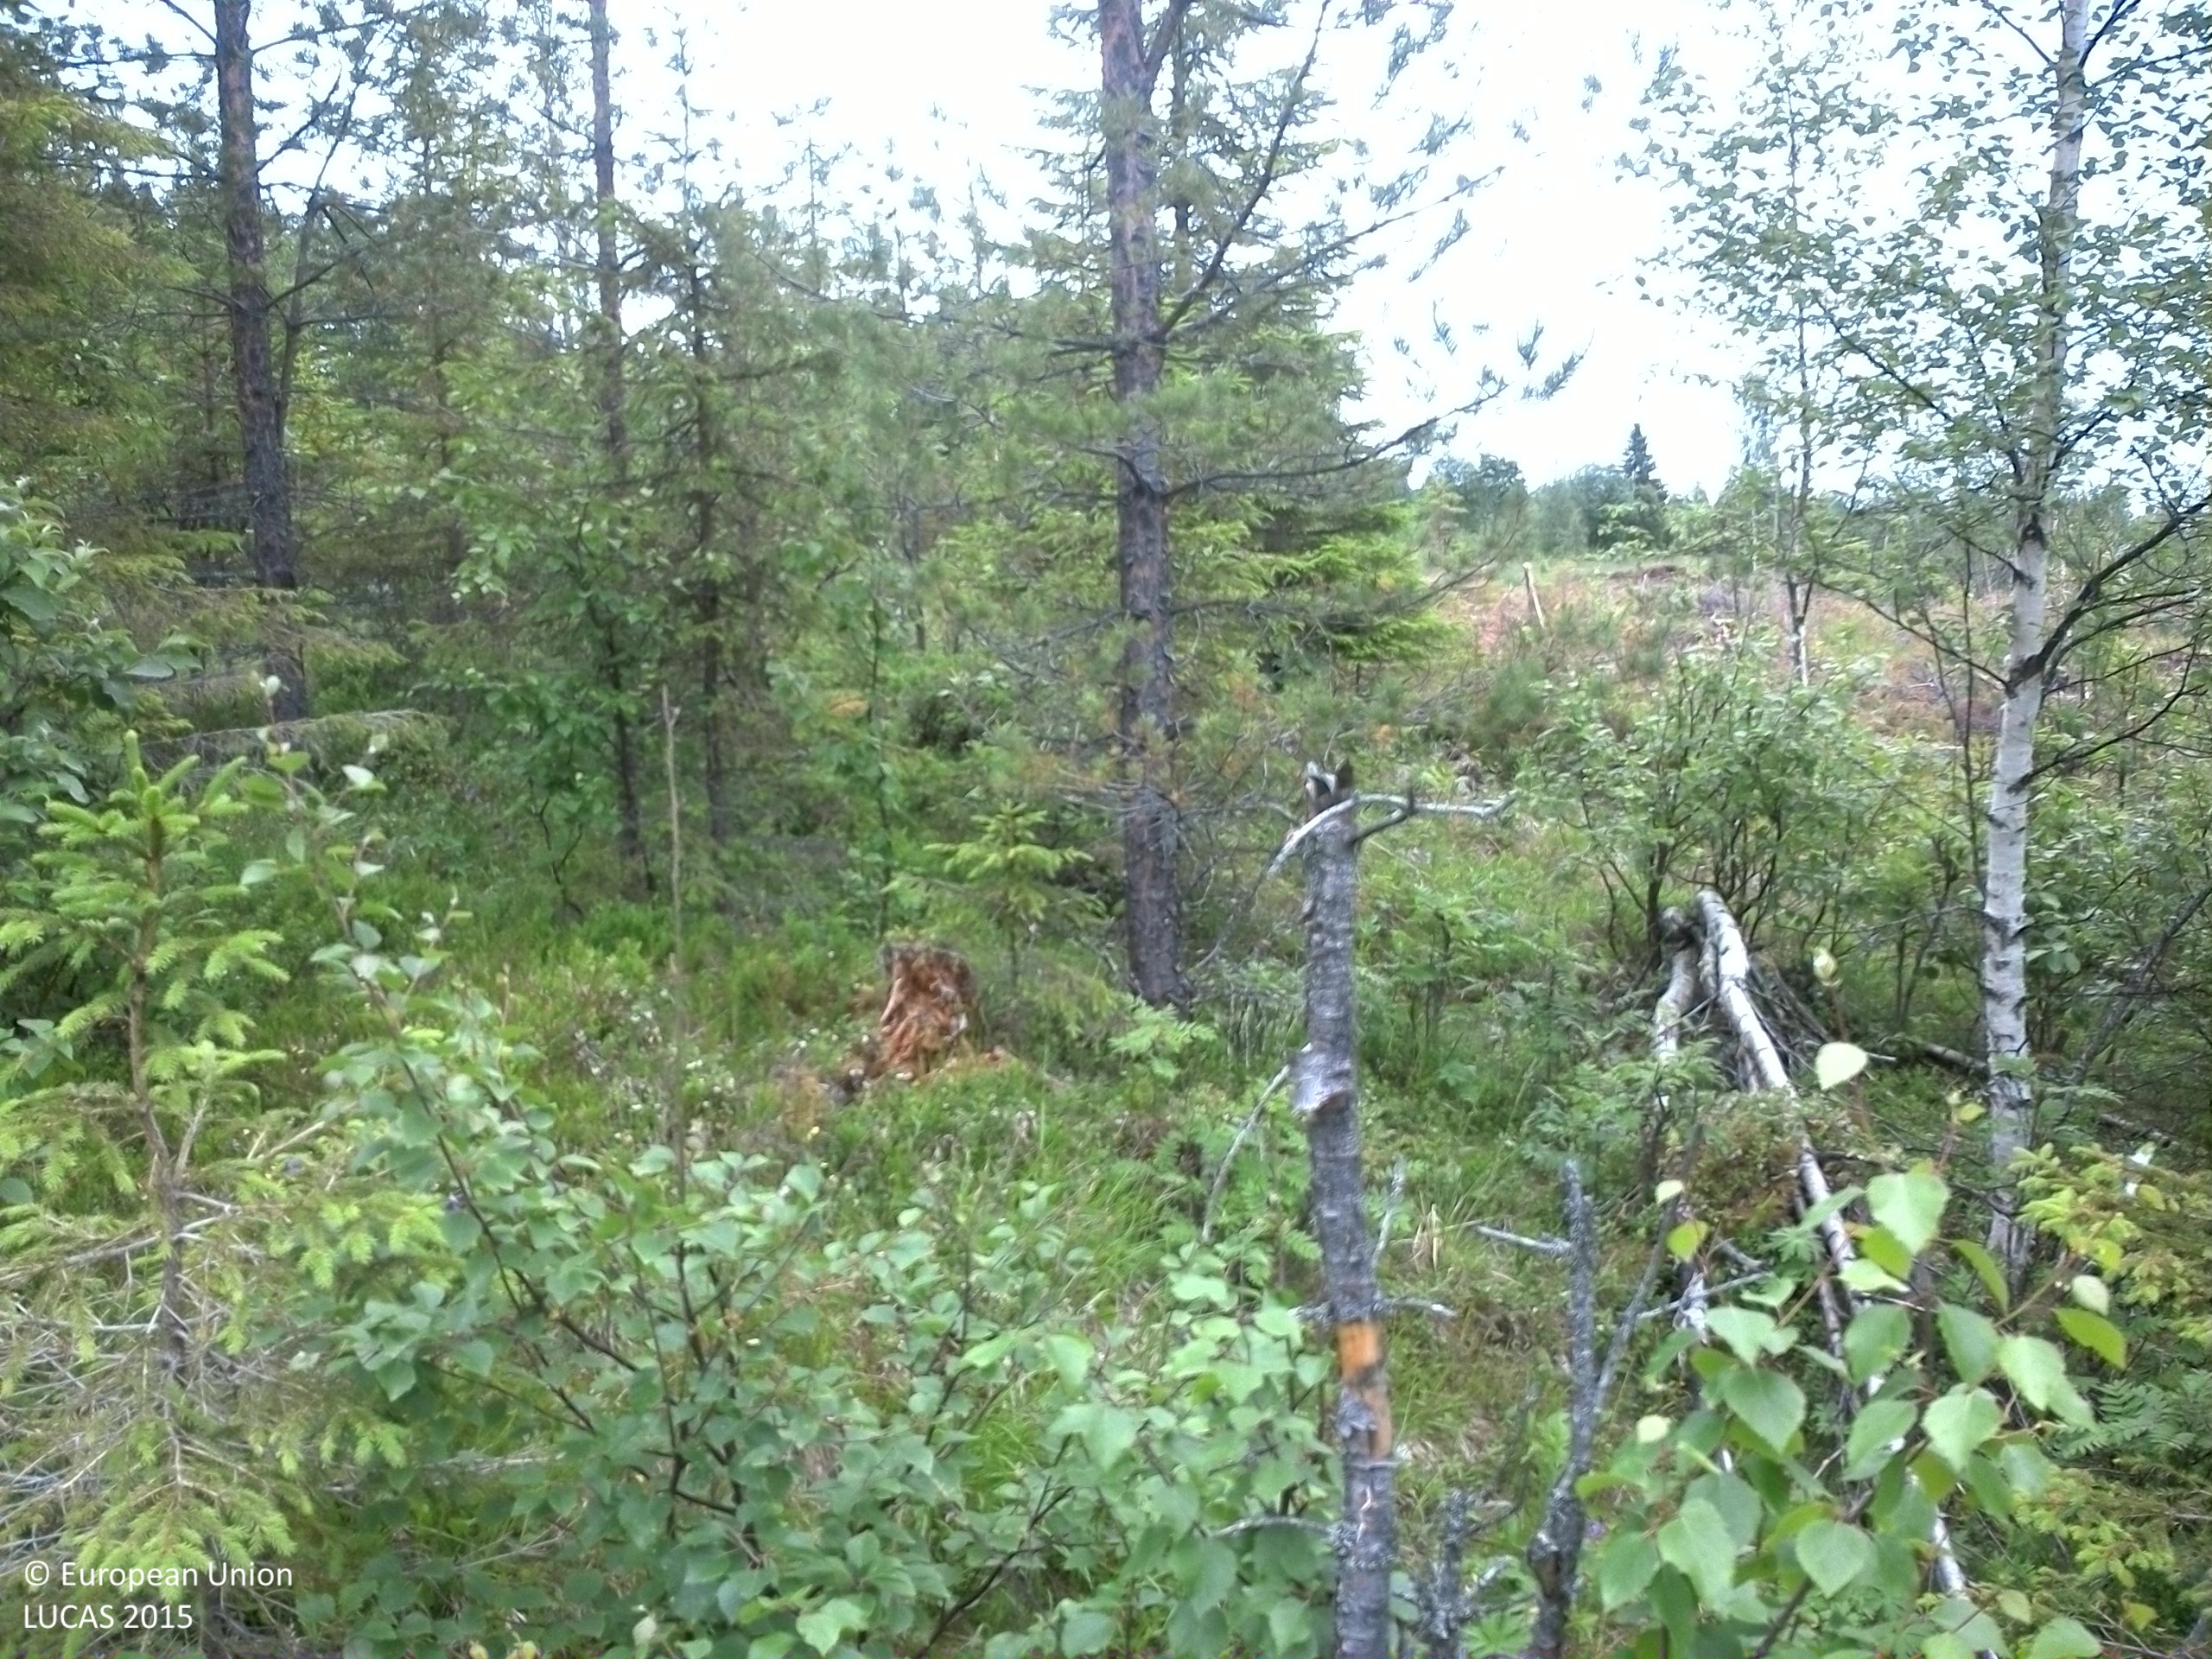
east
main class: Woodland
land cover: Pine dominated mixed woodland
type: boreal forest
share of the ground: 25 - 50 %
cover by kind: coniferous forest trees 30 %, shrubs 30 %, broadleaved forest trees 15 %, herbaceous plants 10 %, lichens and mosses 10 %, consolidated bare surface 5 %
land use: Forestry
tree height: < 5 m
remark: Clear cut
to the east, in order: Pine dominated mixed woodland; Grassland with sparse tree/shrub cover; Shrubland with sparse tree cover; Rocks and stones; Grassland without tree/shrub cover; Broadleaved woodland; Tracks; Rocks and stones; Broadleaved woodland; Rivers and streams; Broadleaved woodland; Grassland without tree/shrub cover; Shrubland without tree cover; Rocks and stones; Grassland without tree/shrub cover; Shrubland without tree cover; Grassland without tree/shrub cover; Electric lines; Grassland without tree/shrub cover
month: July
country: SE
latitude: 64.4292
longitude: 16.0117
